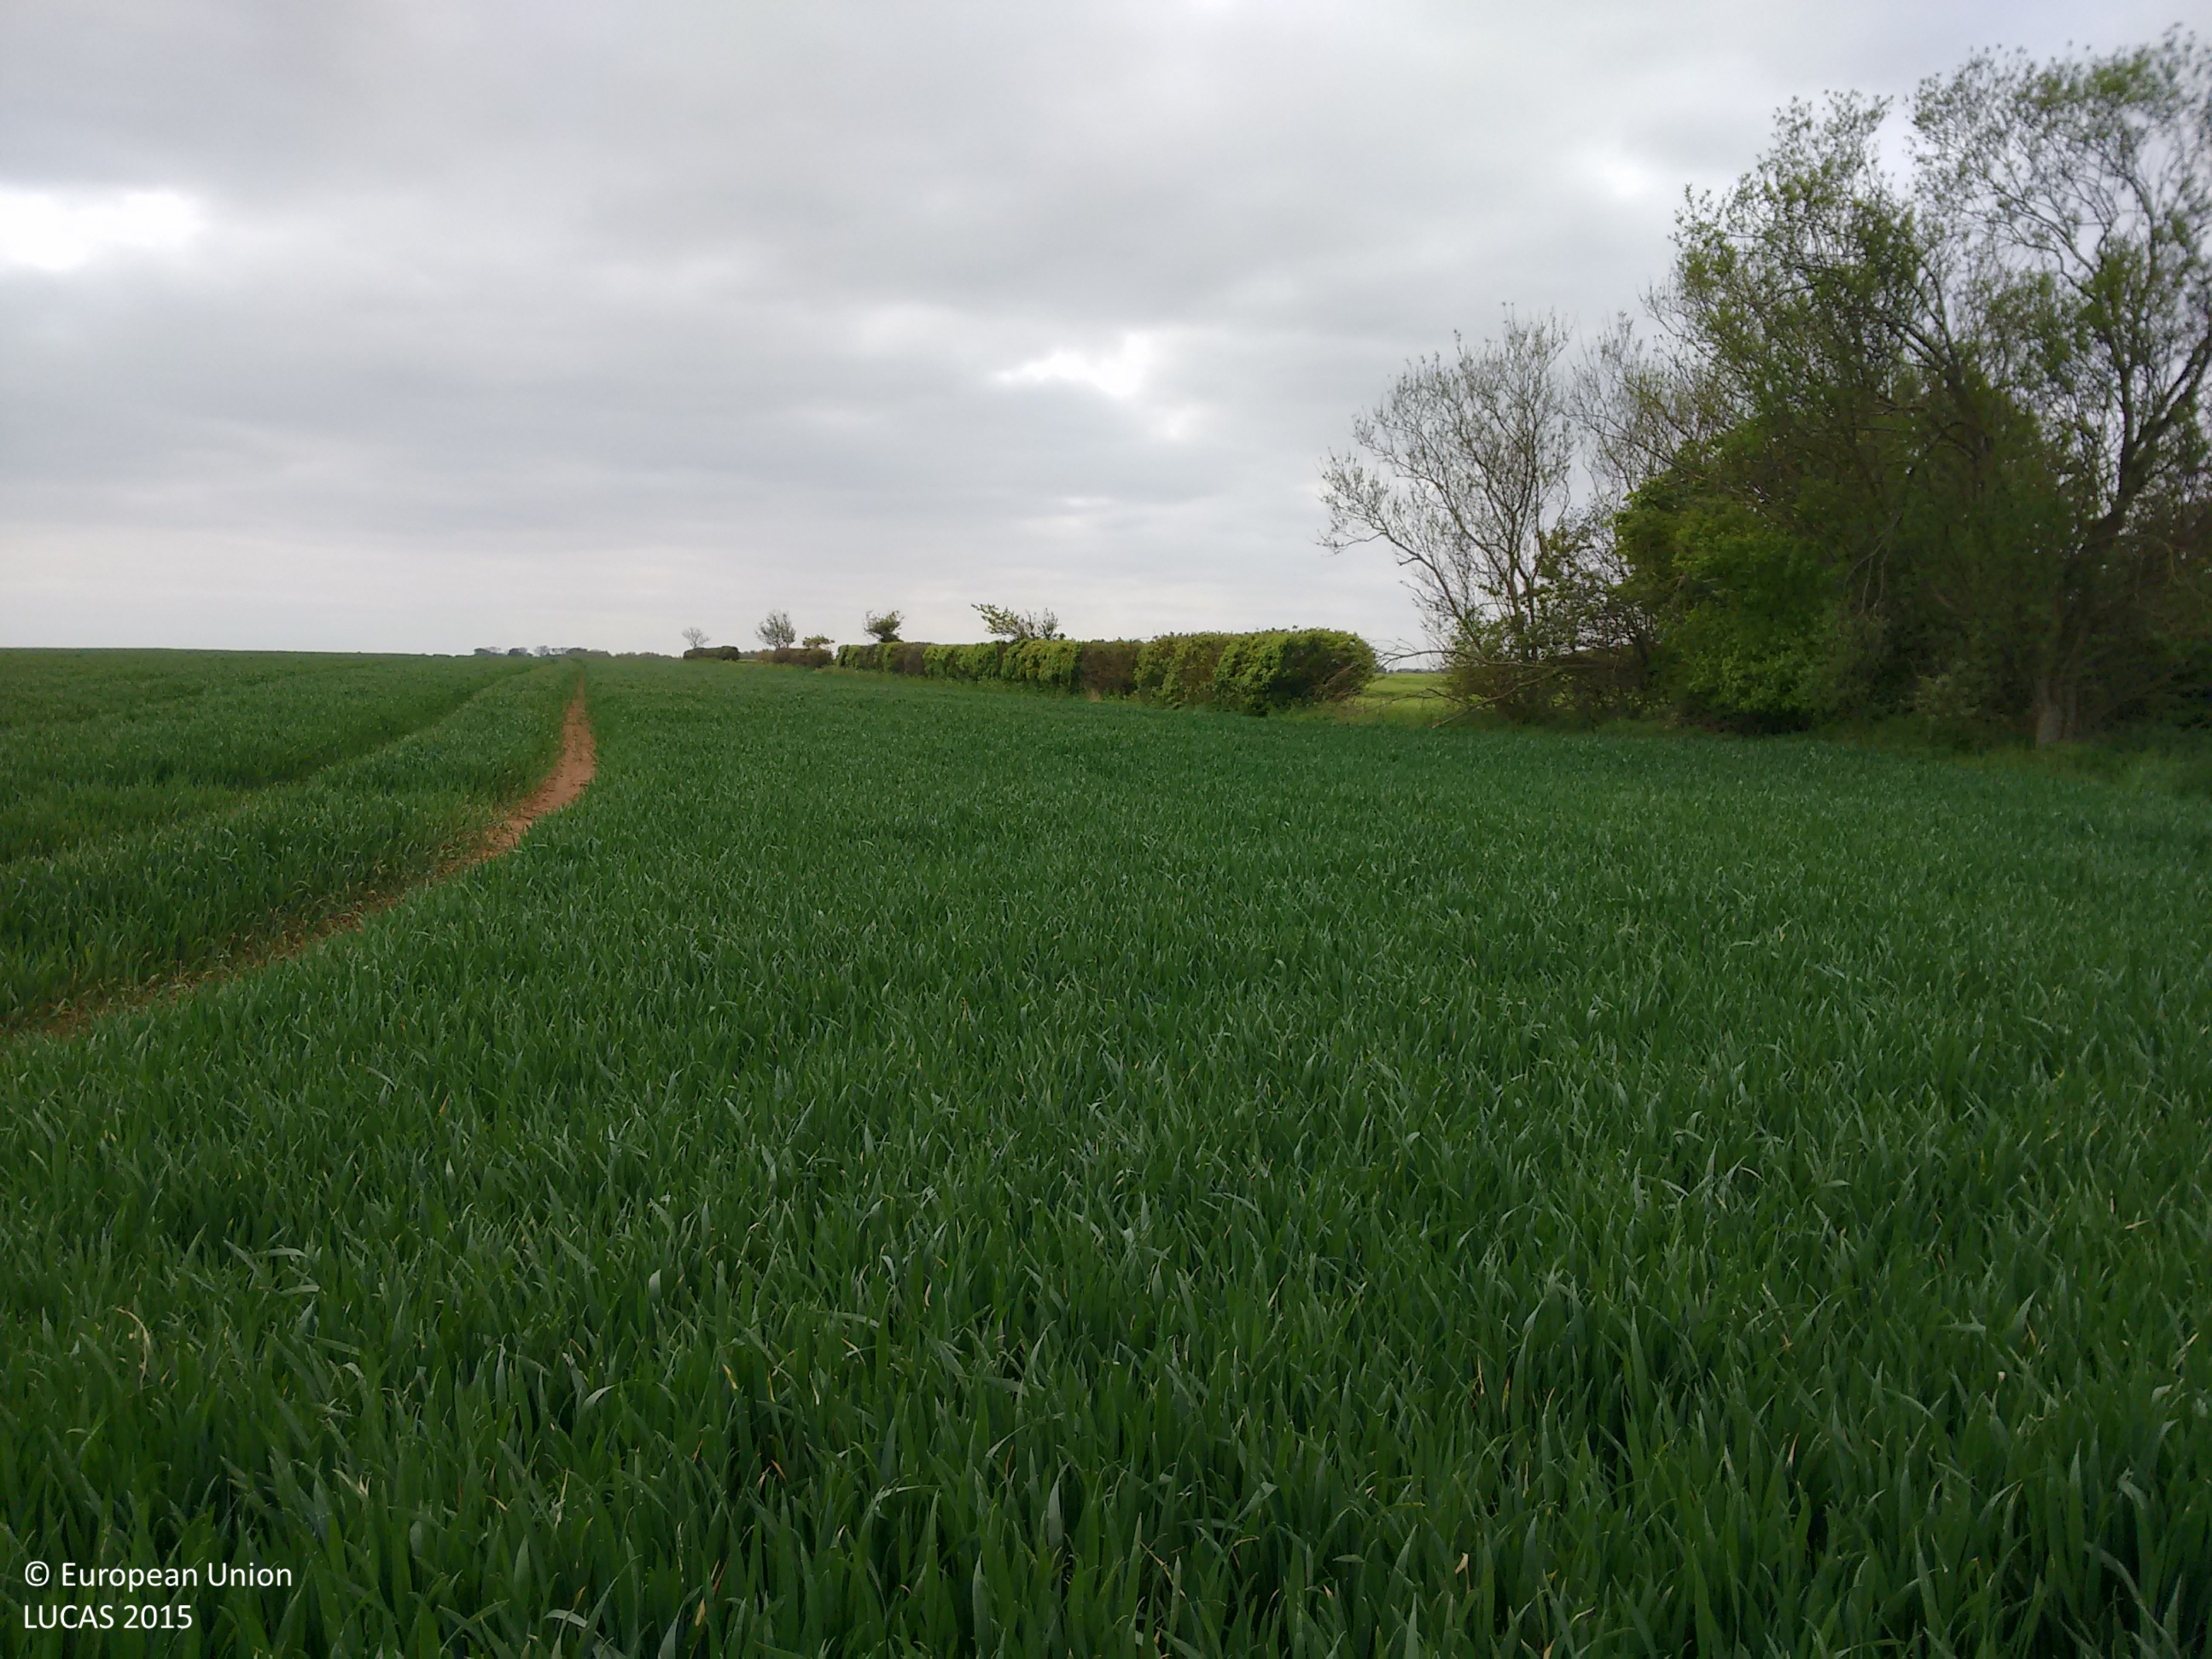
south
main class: Cropland
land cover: Common wheat
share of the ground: > 75 %
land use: Agriculture (excluding fallow land and kitchen gardens)
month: May
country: GB
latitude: 53.7283
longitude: -0.0201
